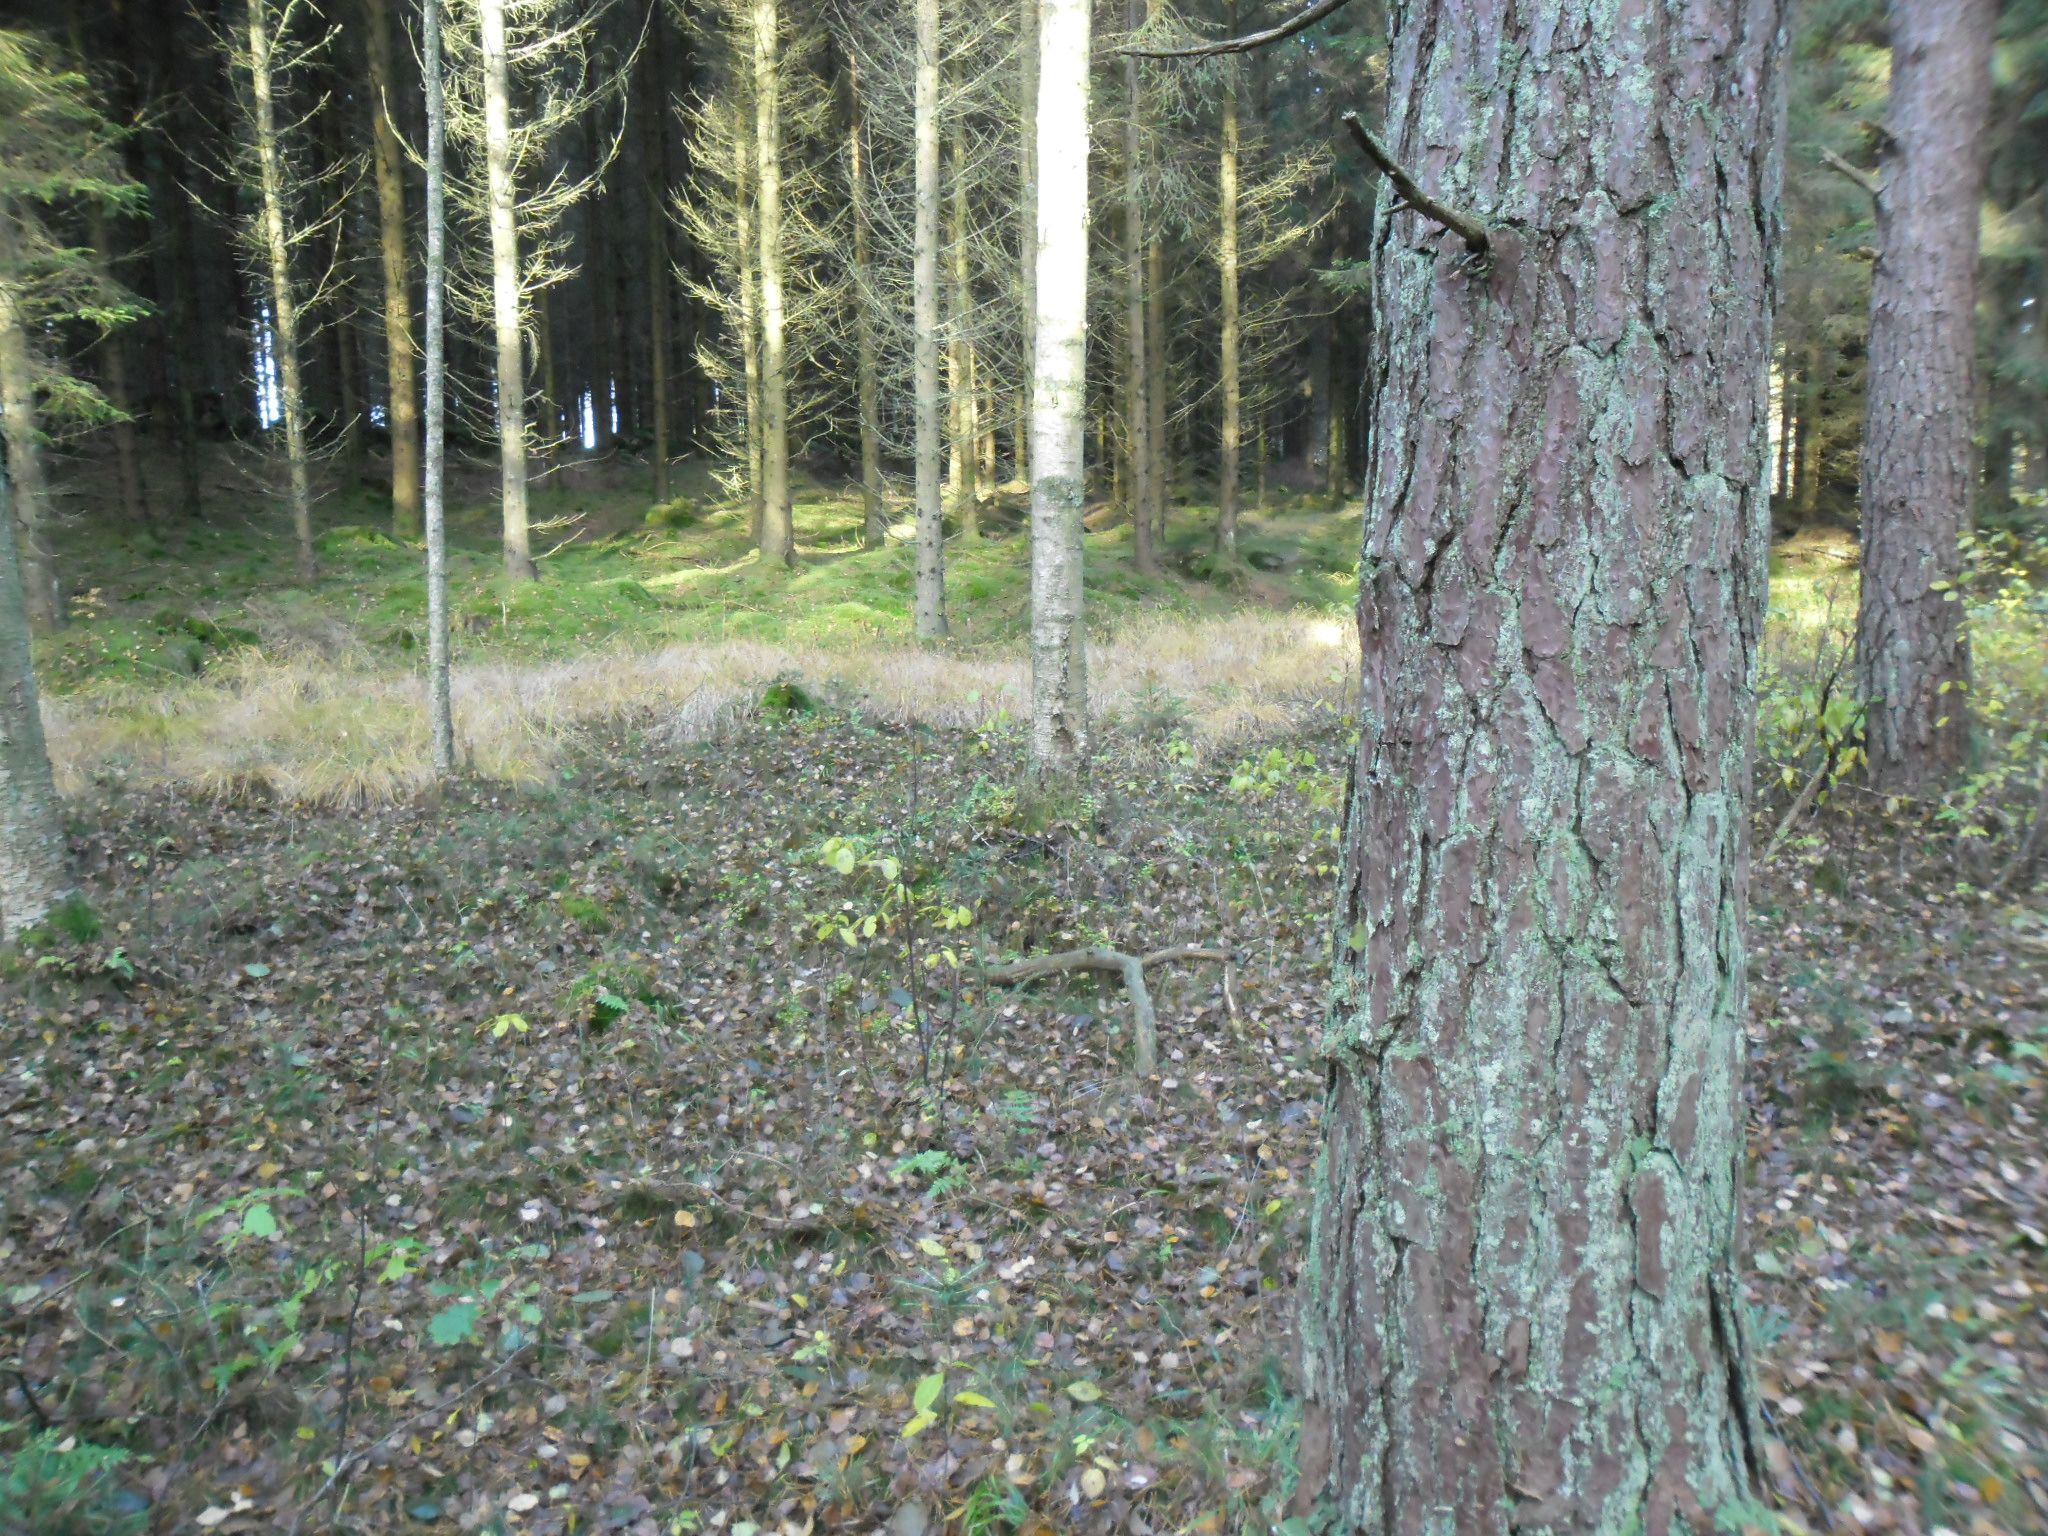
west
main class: Woodland
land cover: Pine dominated mixed woodland
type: boreal forest
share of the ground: > 75 %
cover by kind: coniferous forest trees 50 %, broadleaved forest trees 25 %, herbaceous plants 25 %
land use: Forestry
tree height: > 5 m
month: October
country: SE
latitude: 56.3103
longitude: 13.1817
